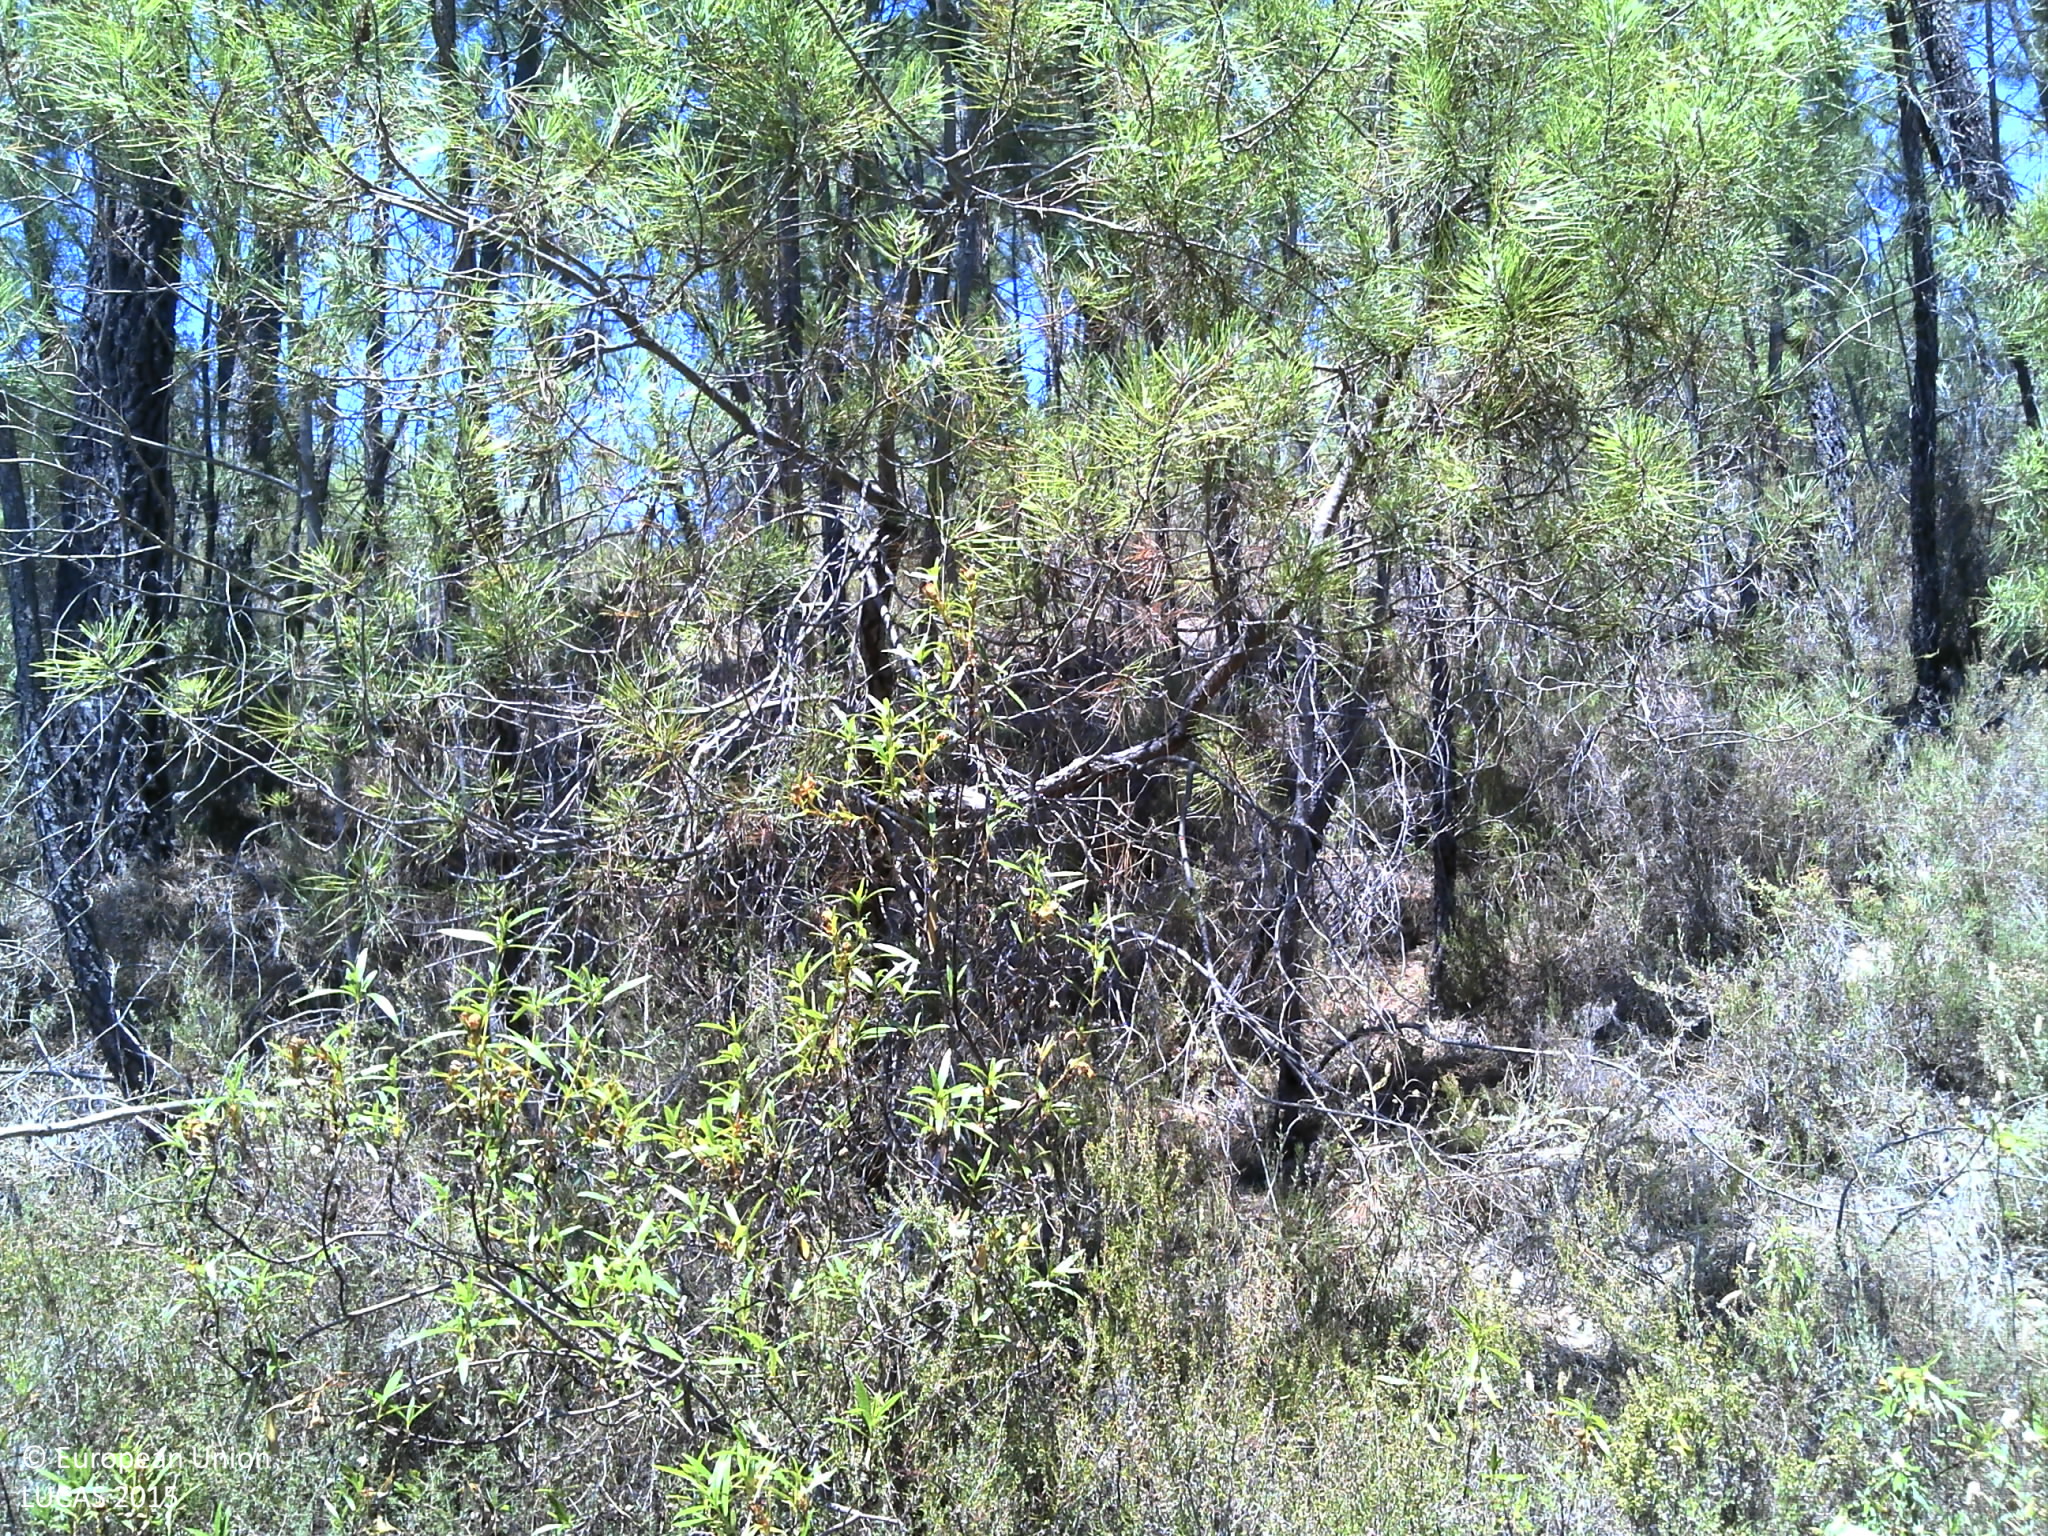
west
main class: Cropland
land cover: Olive groves
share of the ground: < 10 %
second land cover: Shrubland without tree cover
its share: > 75 %
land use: Abandoned areas
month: July
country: PT
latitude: 39.7146
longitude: -7.8003
